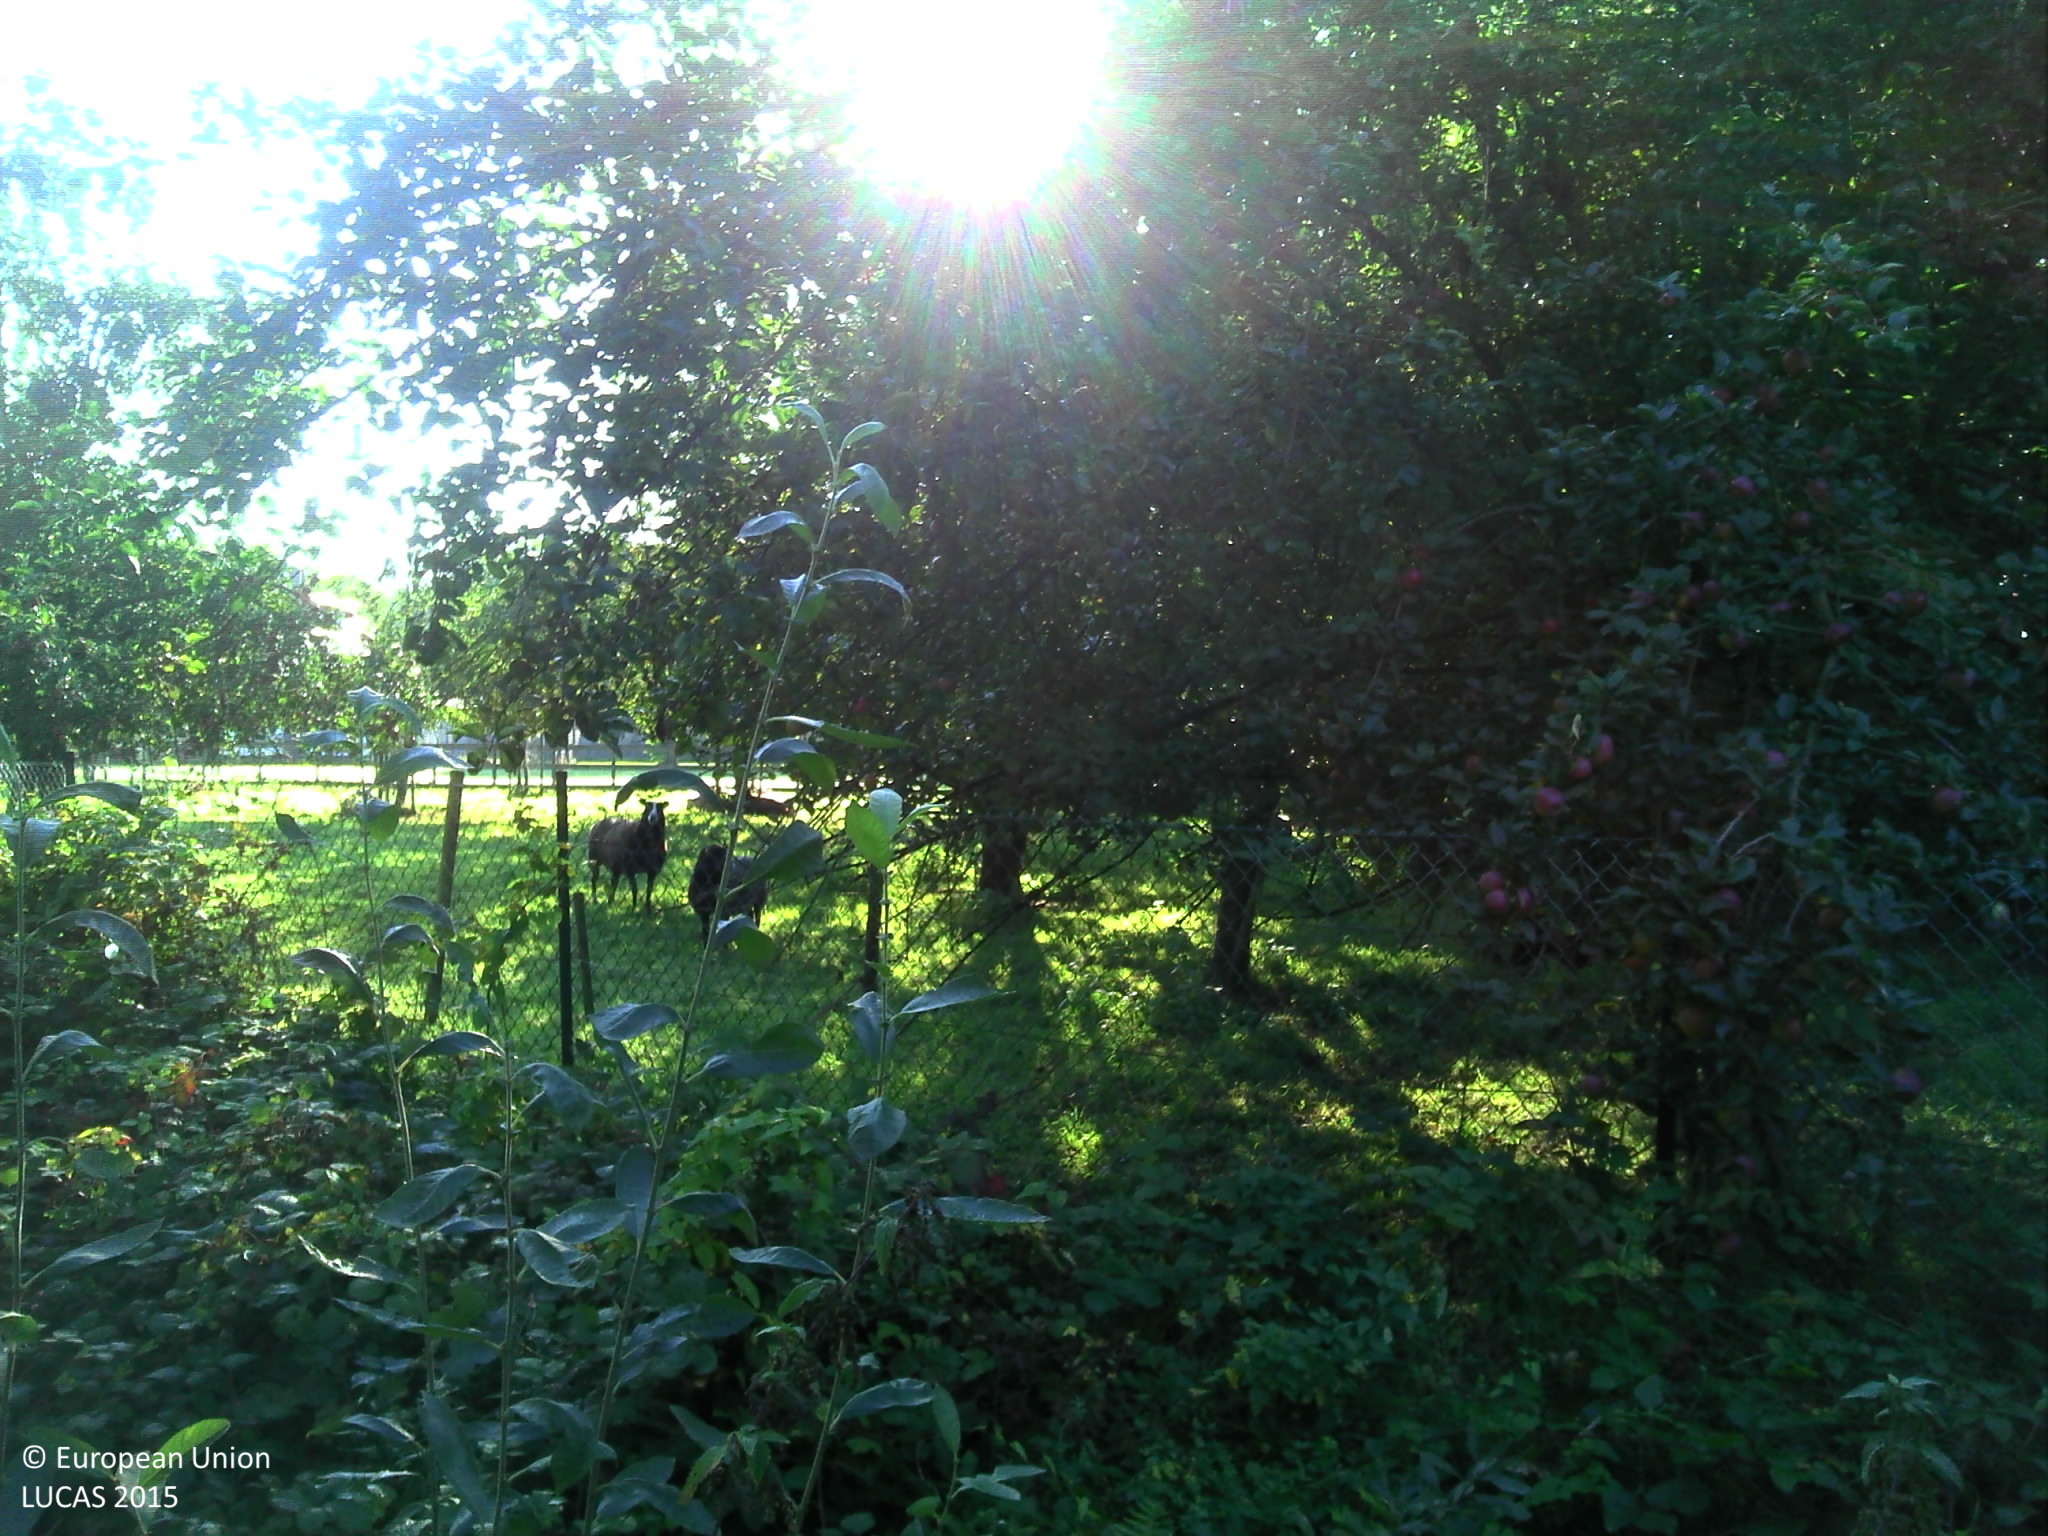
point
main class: Cropland
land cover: Apple fruit
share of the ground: > 75 %
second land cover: Grassland without tree/shrub cover
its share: > 75 %
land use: Agriculture (excluding fallow land and kitchen gardens)
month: September
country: BE
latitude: 51.1943
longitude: 4.6587
